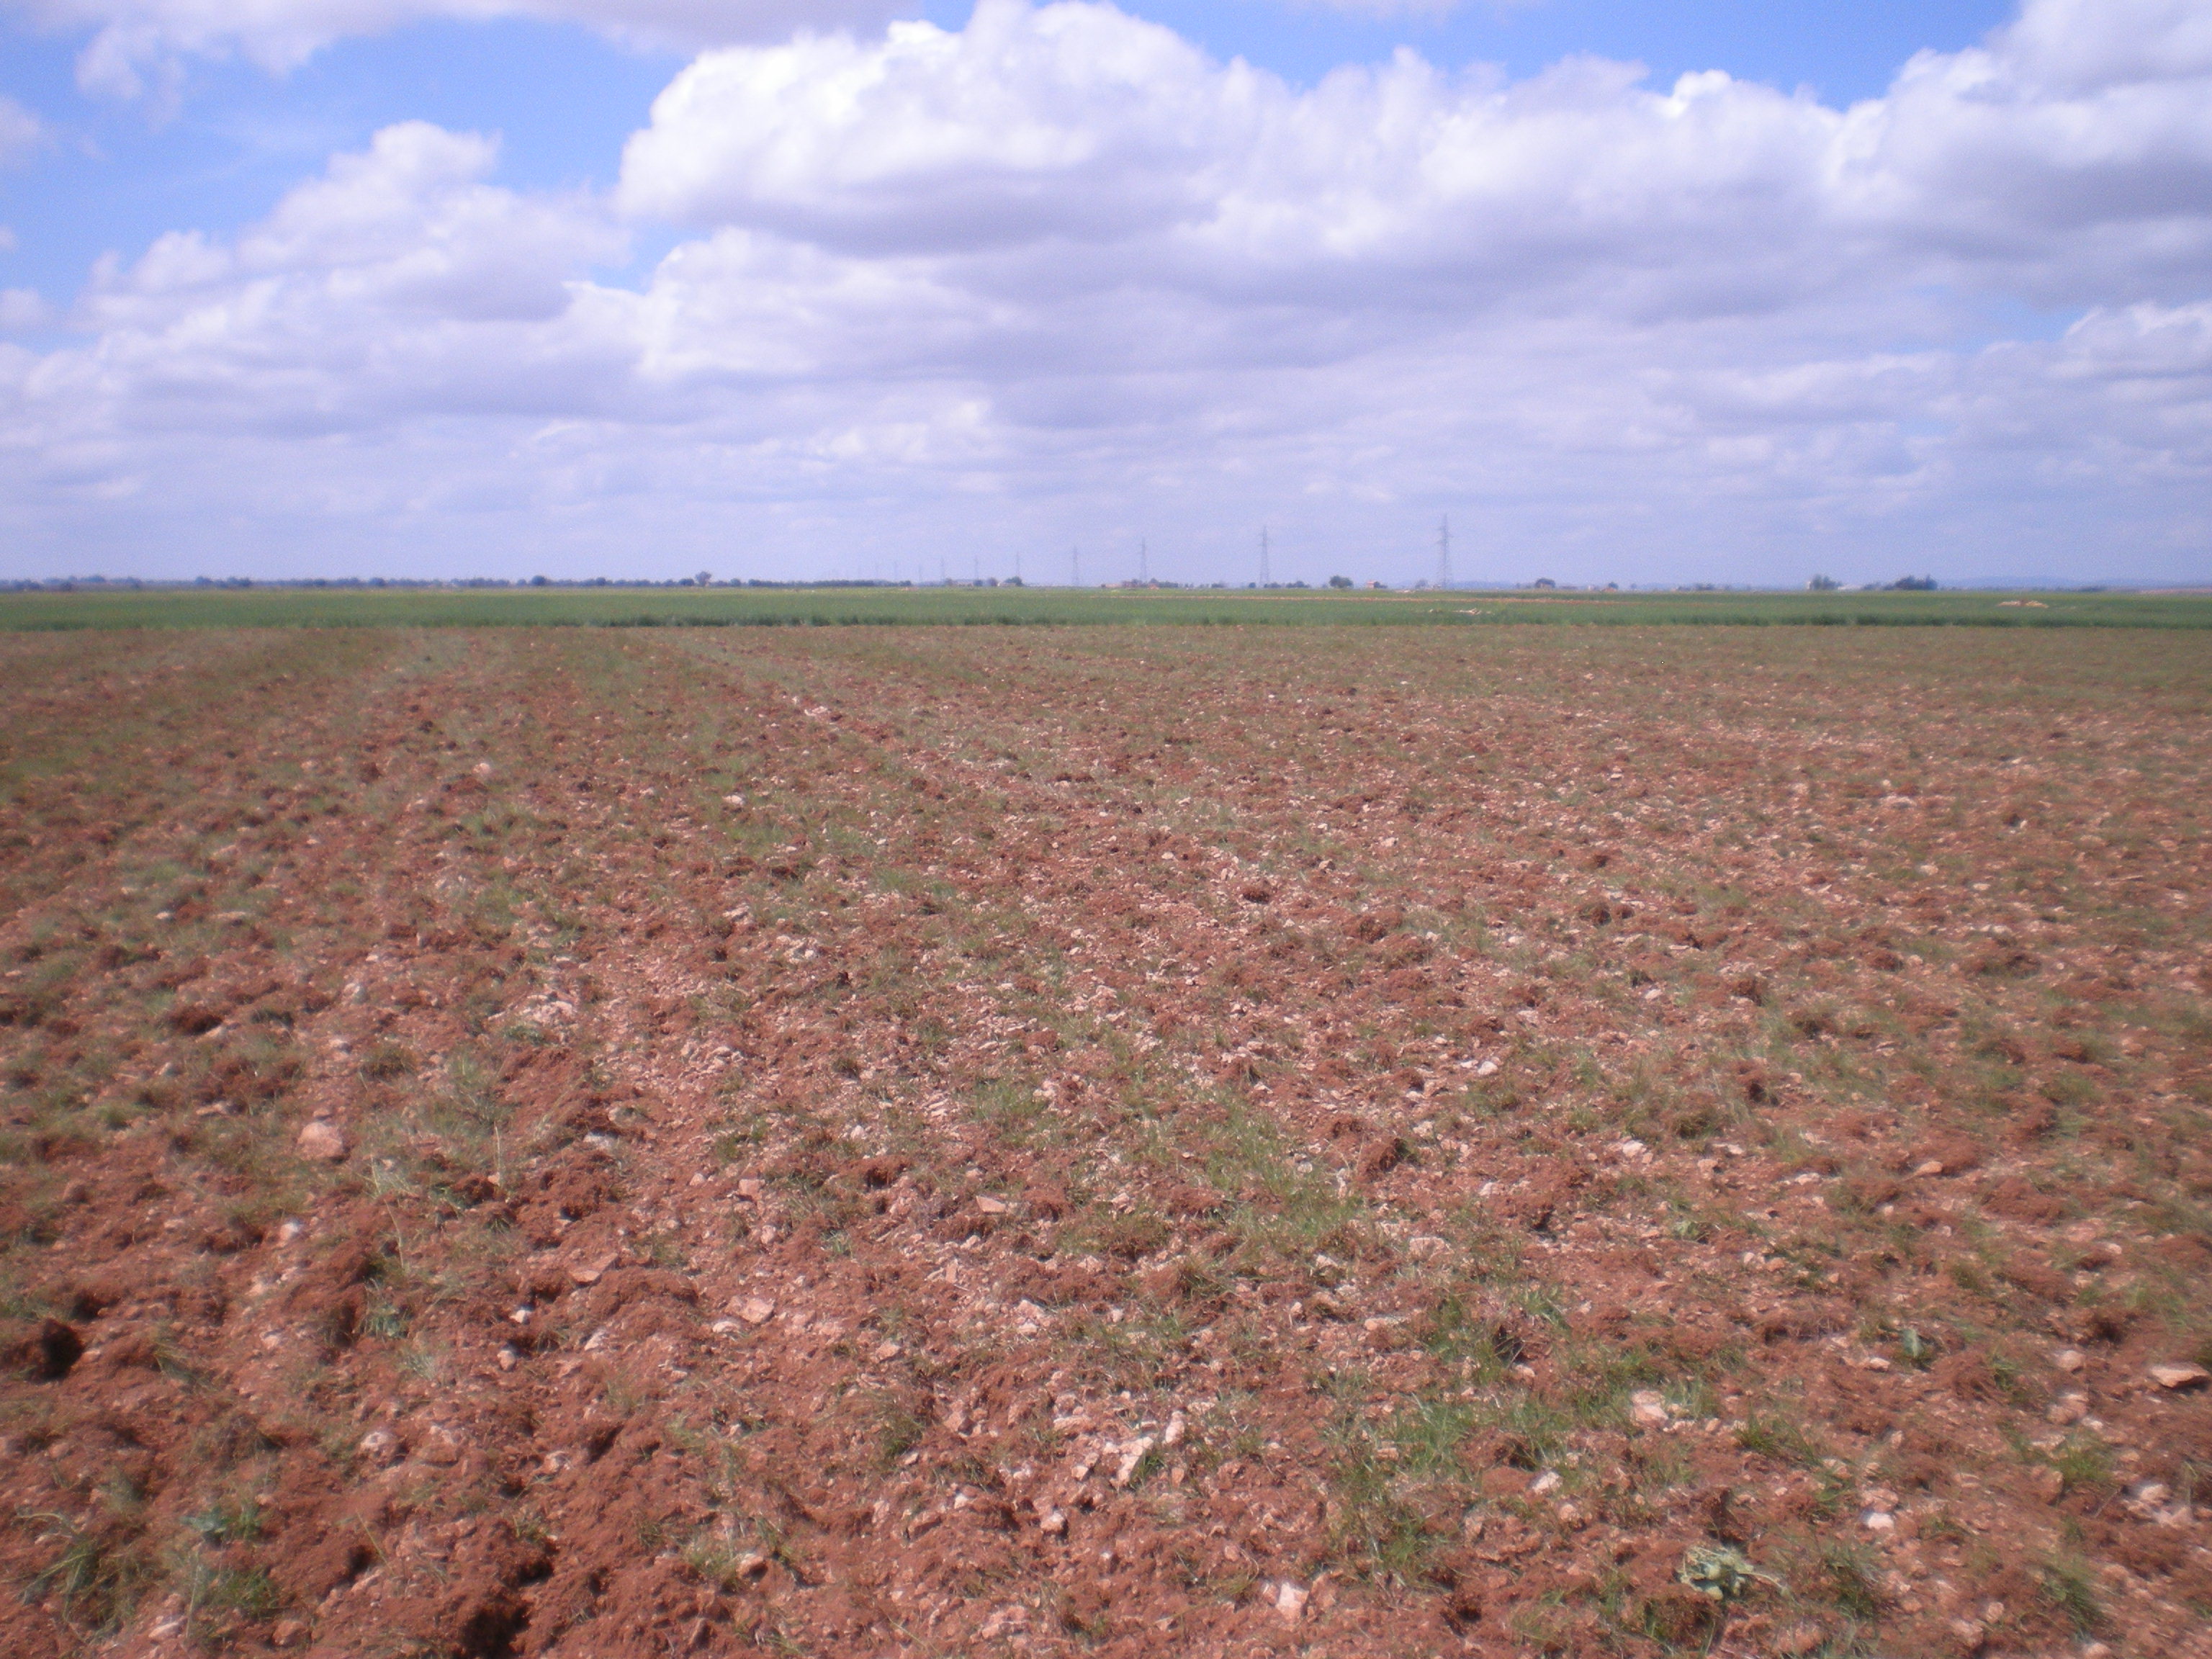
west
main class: Grassland
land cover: Spontaneously vegetated surfaces
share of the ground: 25 - 50 %
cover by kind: unconsolidated bare surface 70 %, herbaceous plants 30 %
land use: Fallow land
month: April
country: ES
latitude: 39.0028
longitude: -3.6079
